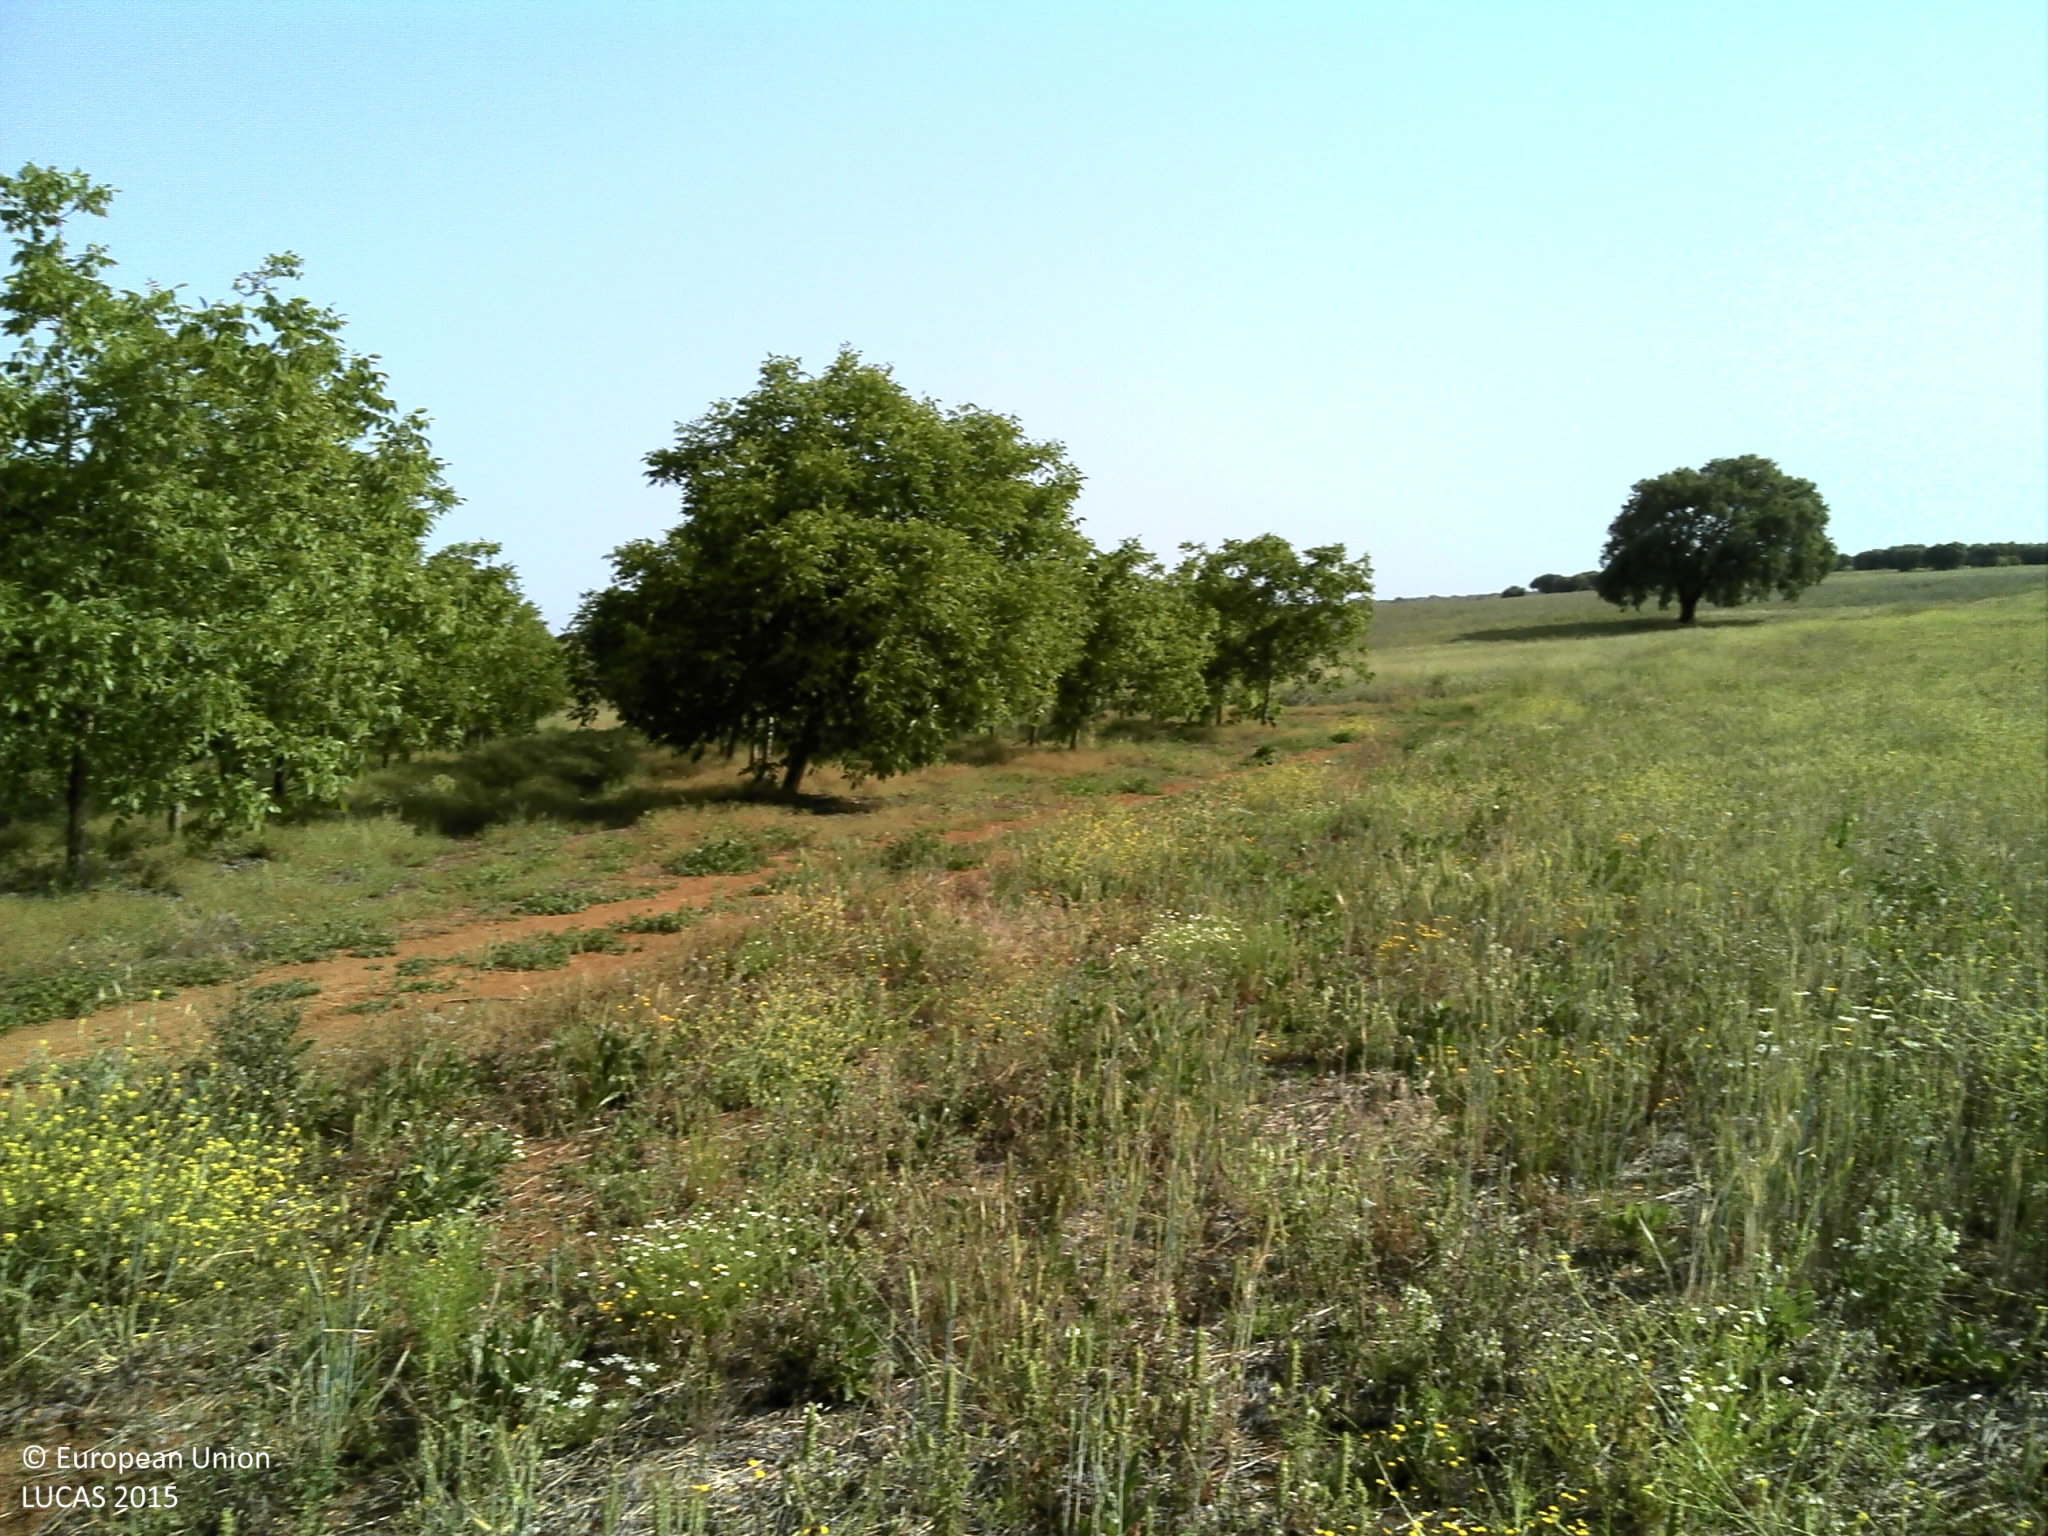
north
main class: Cropland
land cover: Mixed cereals for fodder
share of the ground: > 75 %
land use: Agriculture (excluding fallow land and kitchen gardens)
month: May
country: PT
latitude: 38.9784
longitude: -7.7861
